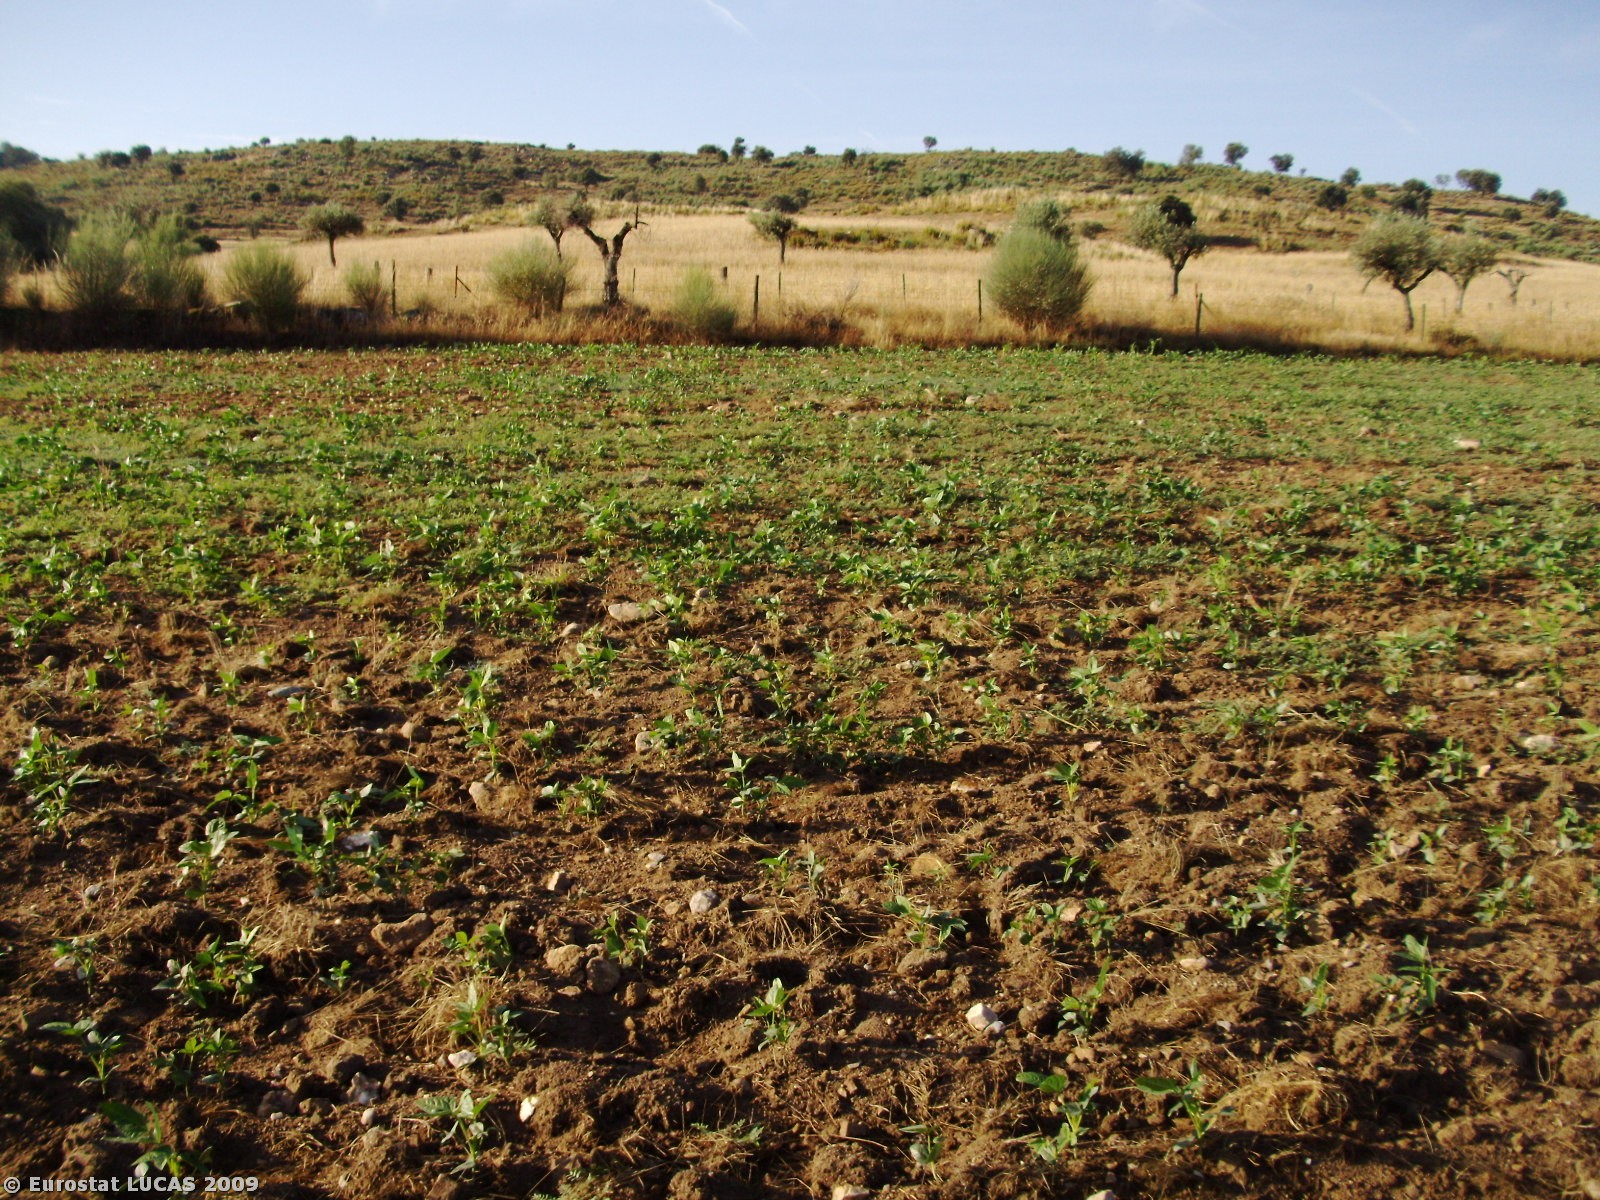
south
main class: Cropland
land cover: Other leguminous and mixtures for fodder
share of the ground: 25 - 50 %
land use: Agriculture (excluding fallow land and kitchen gardens)
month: June
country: PT
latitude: 39.9901
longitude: -7.3017
